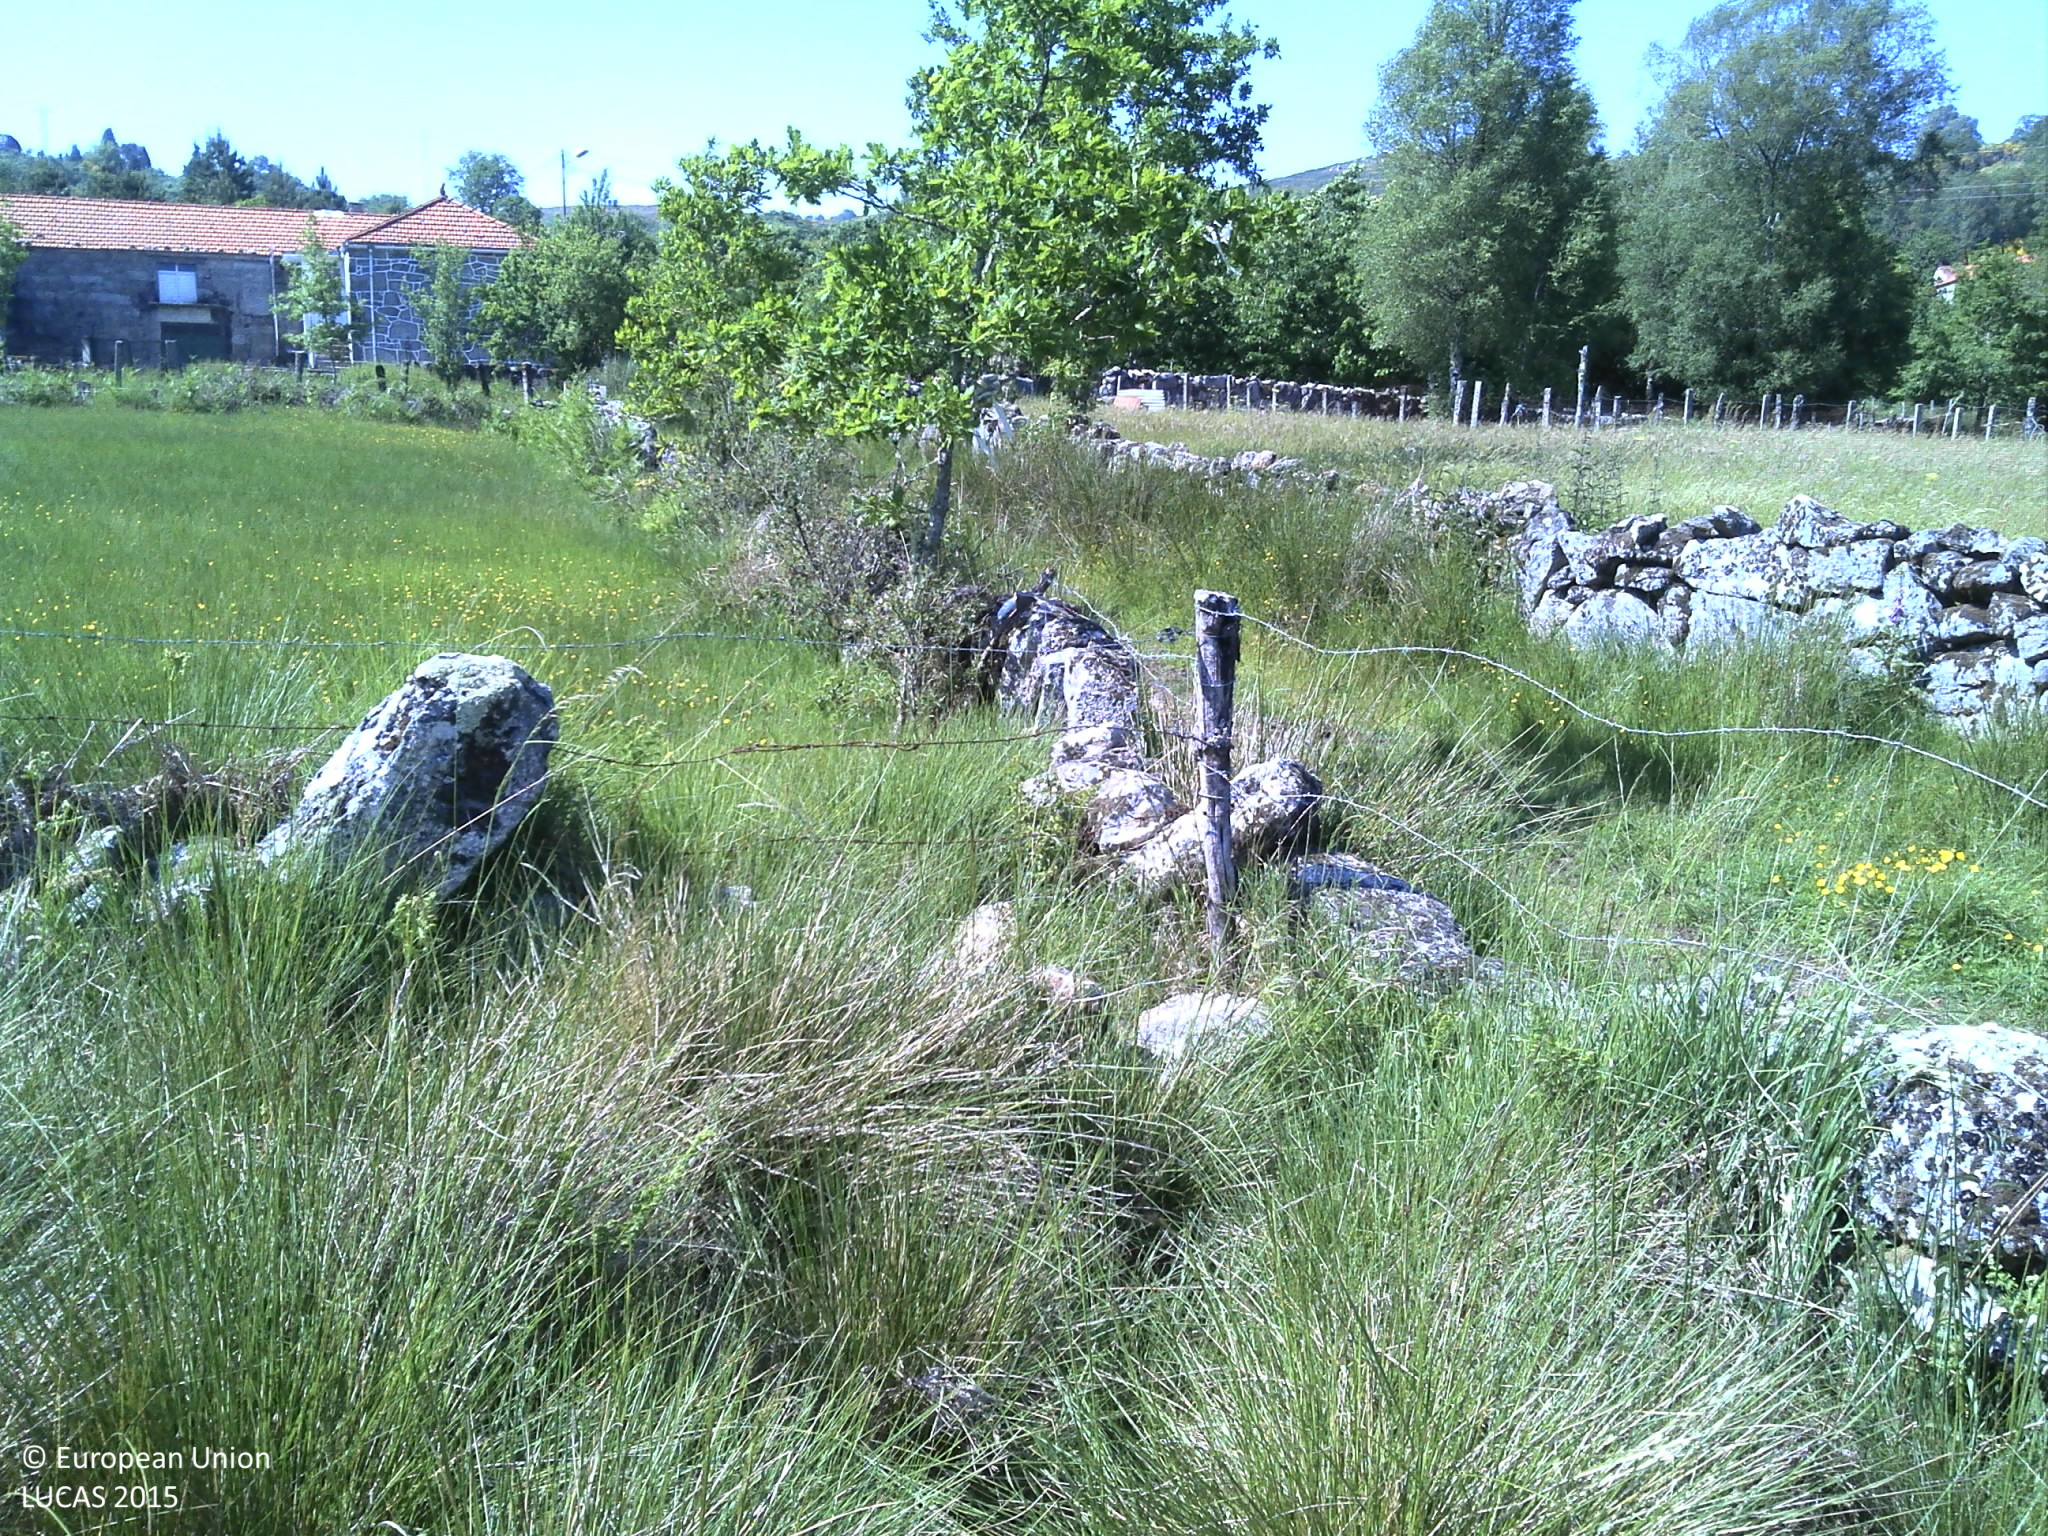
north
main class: Grassland
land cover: Grassland without tree/shrub cover
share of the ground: > 75 %
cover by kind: herbaceous plants 85 %, unconsolidated bare surface 15 %
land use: Agriculture (excluding fallow land and kitchen gardens)
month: June
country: PT
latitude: 42.0470
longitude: -8.1681
